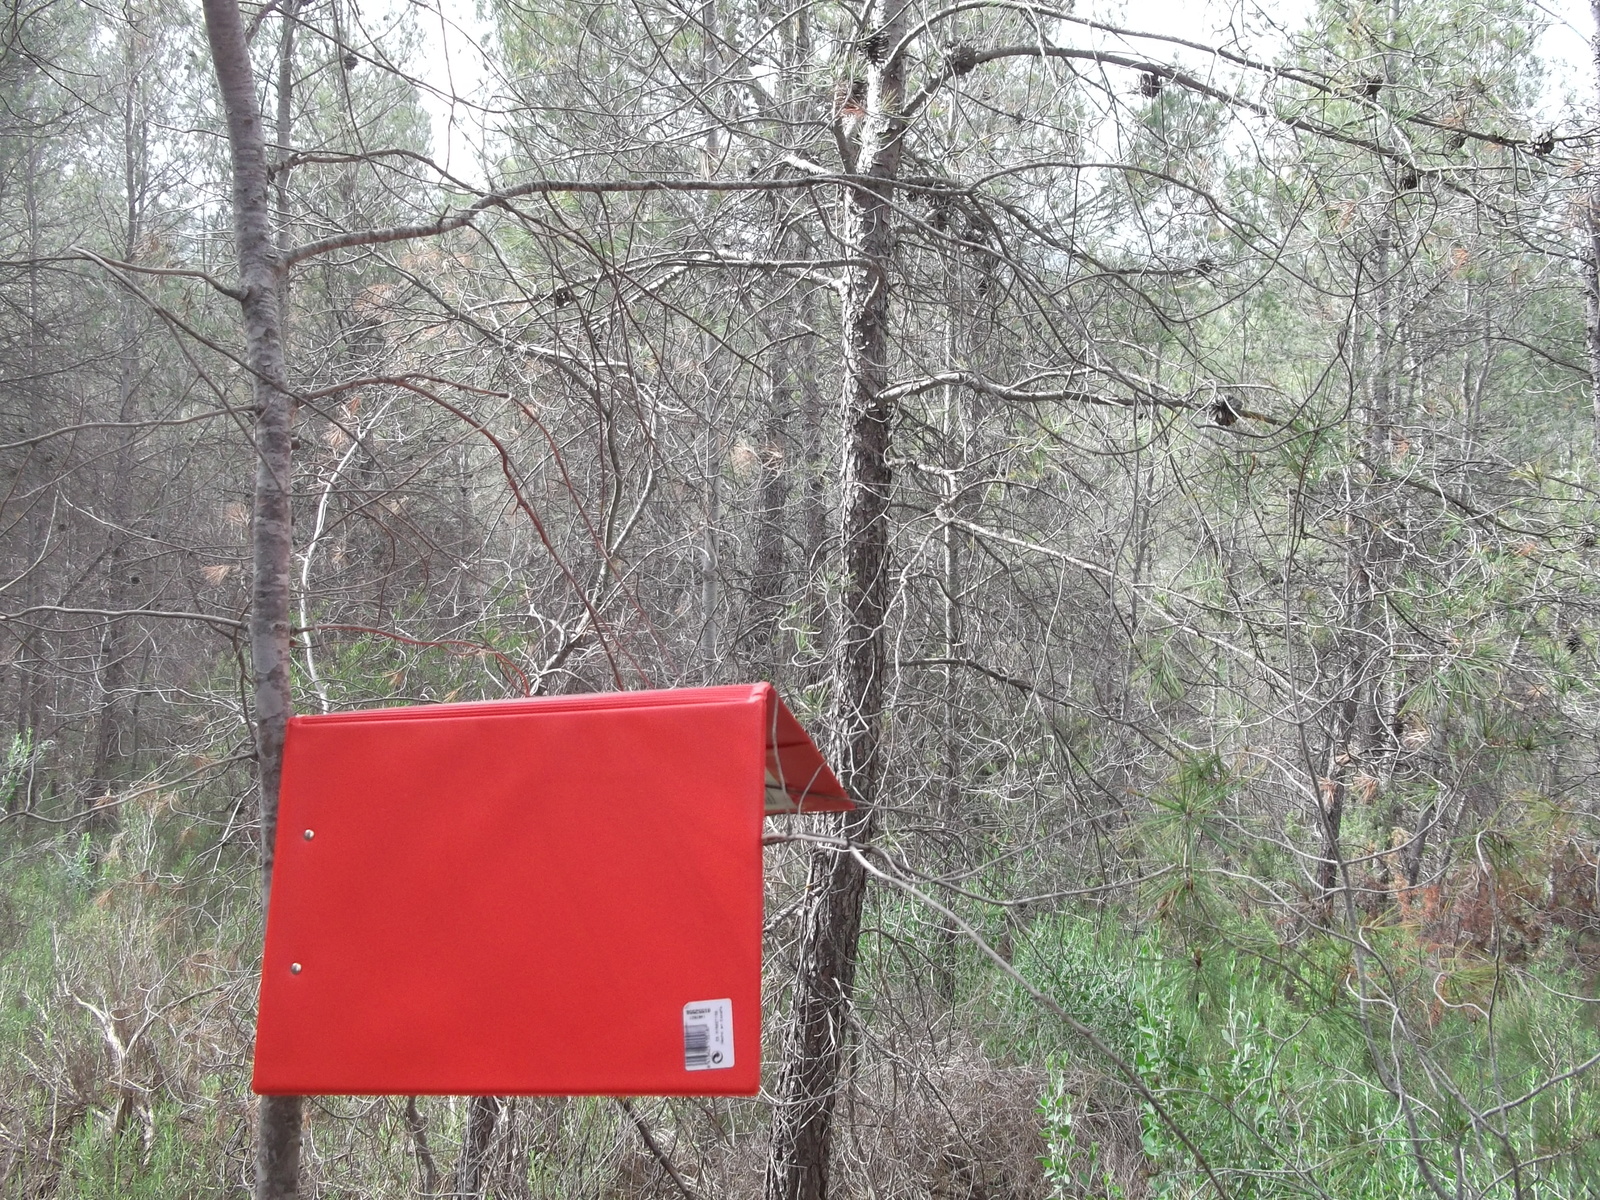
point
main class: Woodland
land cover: Pine dominated coniferous woodland
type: coniferous forest of the mediterranean region
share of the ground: 25 - 50 %
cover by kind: shrubs 60 %, coniferous forest trees 40 %
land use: Forestry
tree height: > 5 m
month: April
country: ES
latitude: 37.9370
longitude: -1.5570
